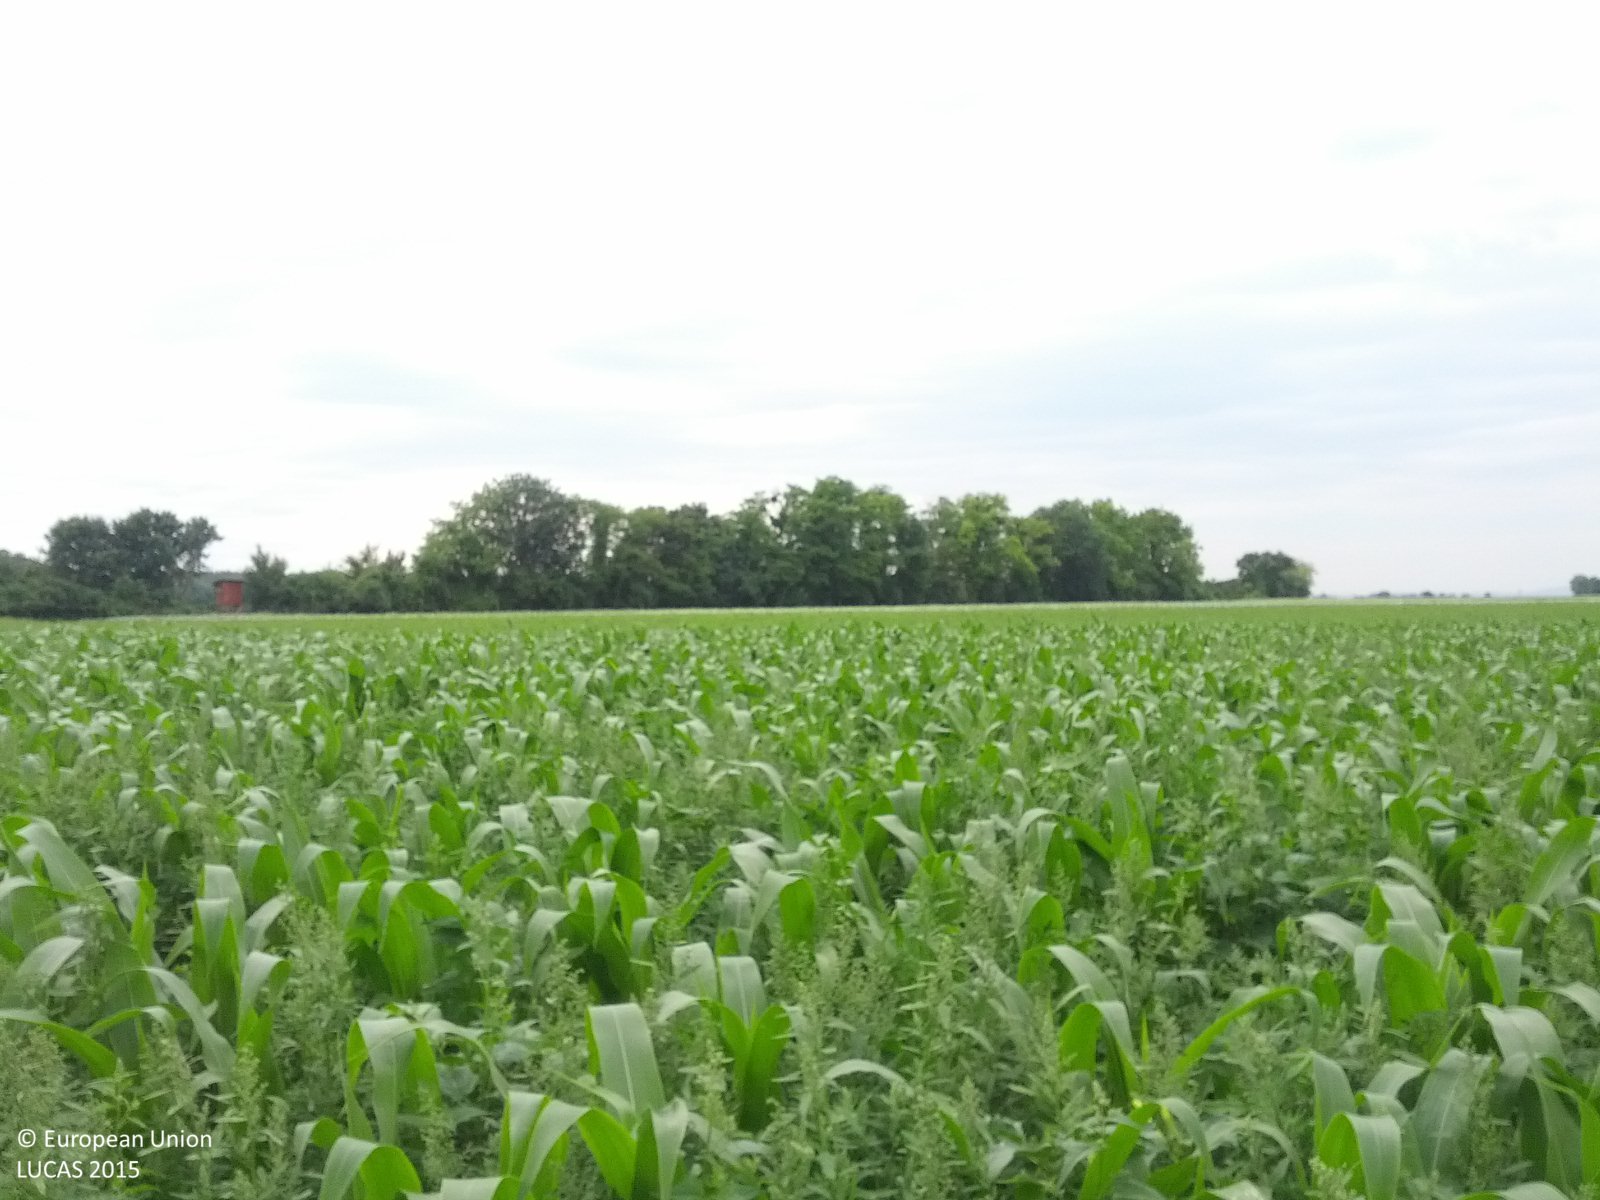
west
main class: Cropland
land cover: Maize
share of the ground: > 75 %
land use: Agriculture (excluding fallow land and kitchen gardens)
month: June
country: AT
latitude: 48.1420
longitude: 16.7664
